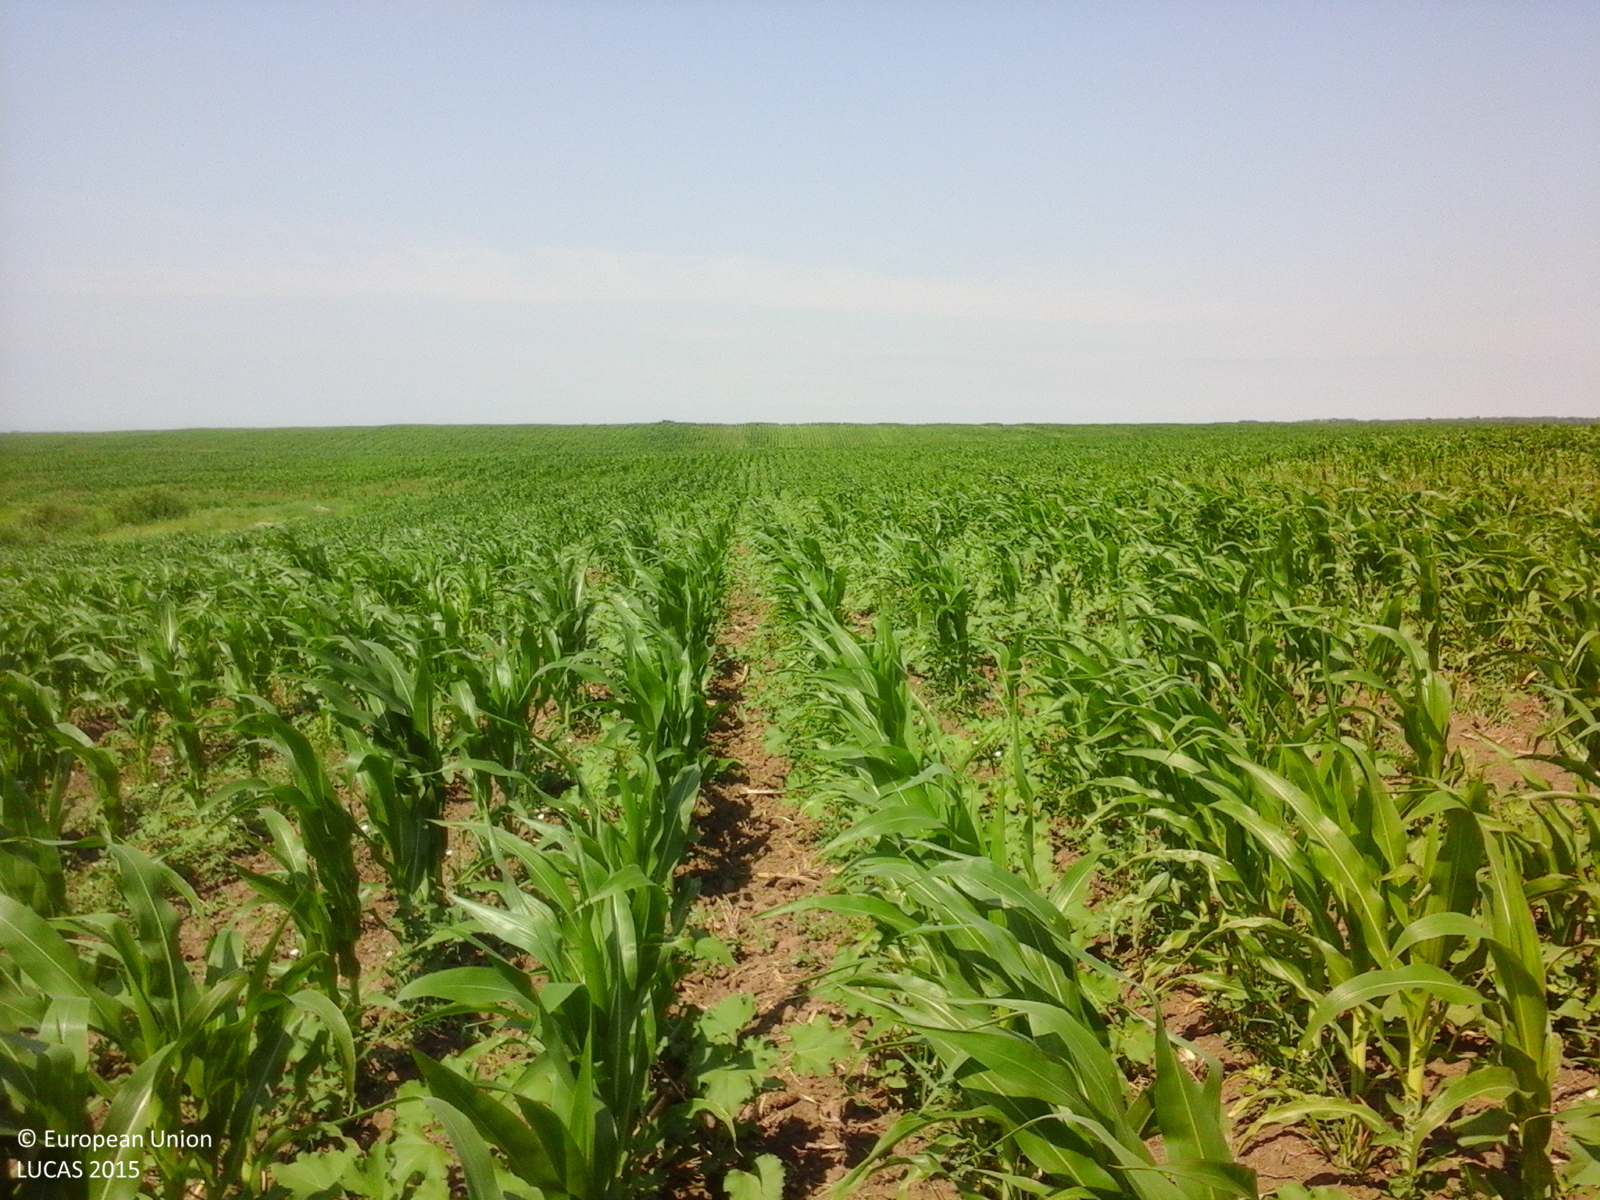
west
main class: Cropland
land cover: Maize
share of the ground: 50 - 75 %
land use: Agriculture (excluding fallow land and kitchen gardens)
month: June
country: RO
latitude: 46.7787
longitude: 27.0067
